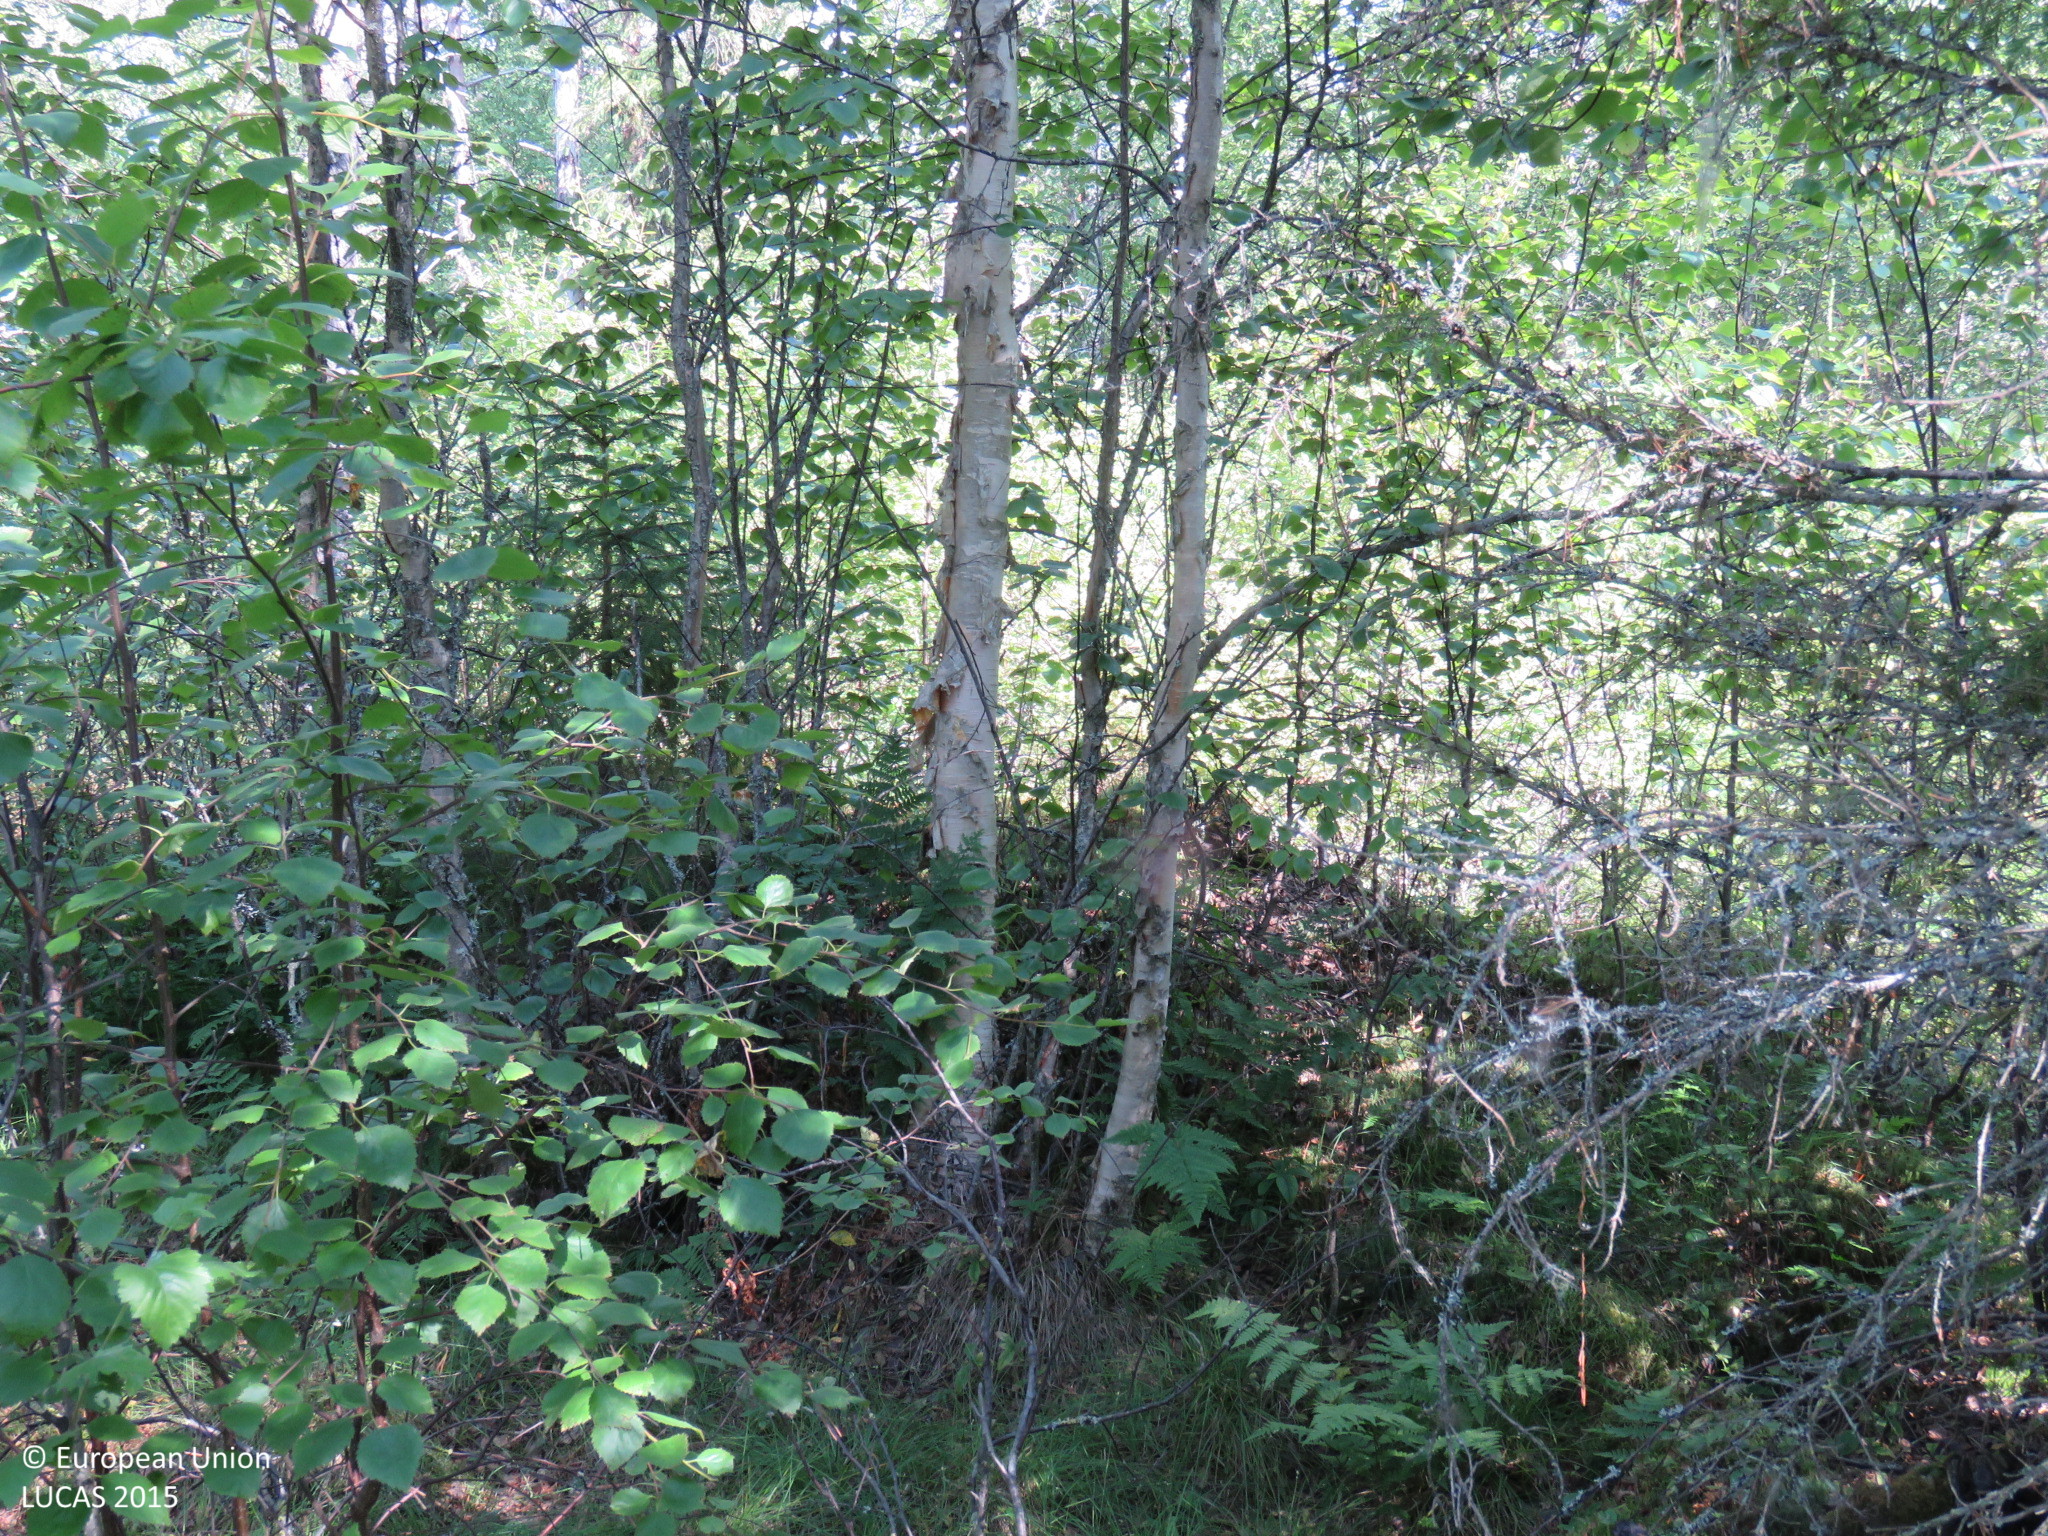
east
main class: Woodland
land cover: Pine dominated mixed woodland
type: mire and swamp forests
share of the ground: > 75 %
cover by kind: broadleaved forest trees 45 %, coniferous forest trees 35 %, herbaceous plants 10 %, shrubs 5 %, lichens and mosses 5 %
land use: Forestry
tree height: > 5 m
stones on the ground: < 10 %
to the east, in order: Pine dominated mixed woodland; Ditches and canals; Pine dominated mixed woodland; Ditches and canals; Pine dominated mixed woodland; Ditches and canals; Pine dominated mixed woodland; Ditches and canals; Pine dominated mixed woodland; Ditches and canals; Grassland with sparse tree/shrub cover; Ditches and canals; Grassland with sparse tree/shrub cover; Ditches and canals; Grassland with sparse tree/shrub cover; Other mixed woodland
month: July
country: FI
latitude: 64.7243
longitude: 26.2039
